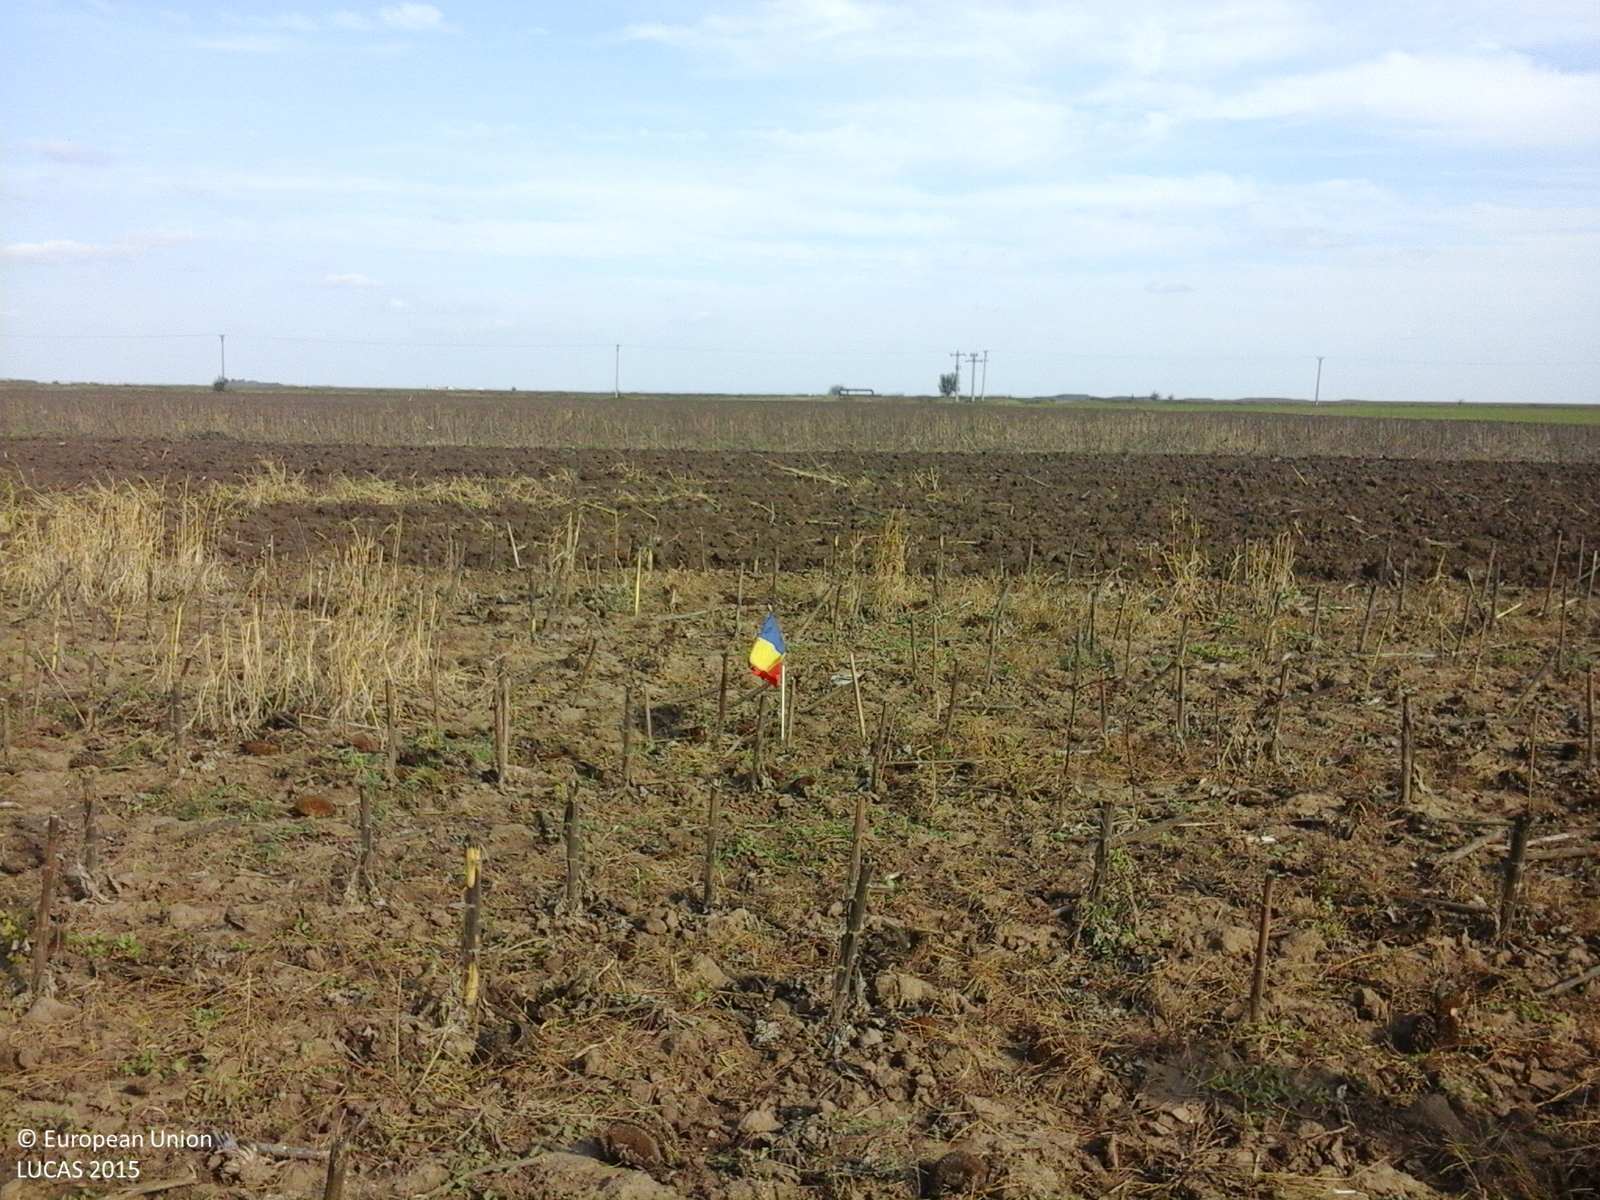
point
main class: Cropland
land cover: Sunflower
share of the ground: 10 - 25 %
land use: Agriculture (excluding fallow land and kitchen gardens)
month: October
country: RO
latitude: 45.1957
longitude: 27.2382
